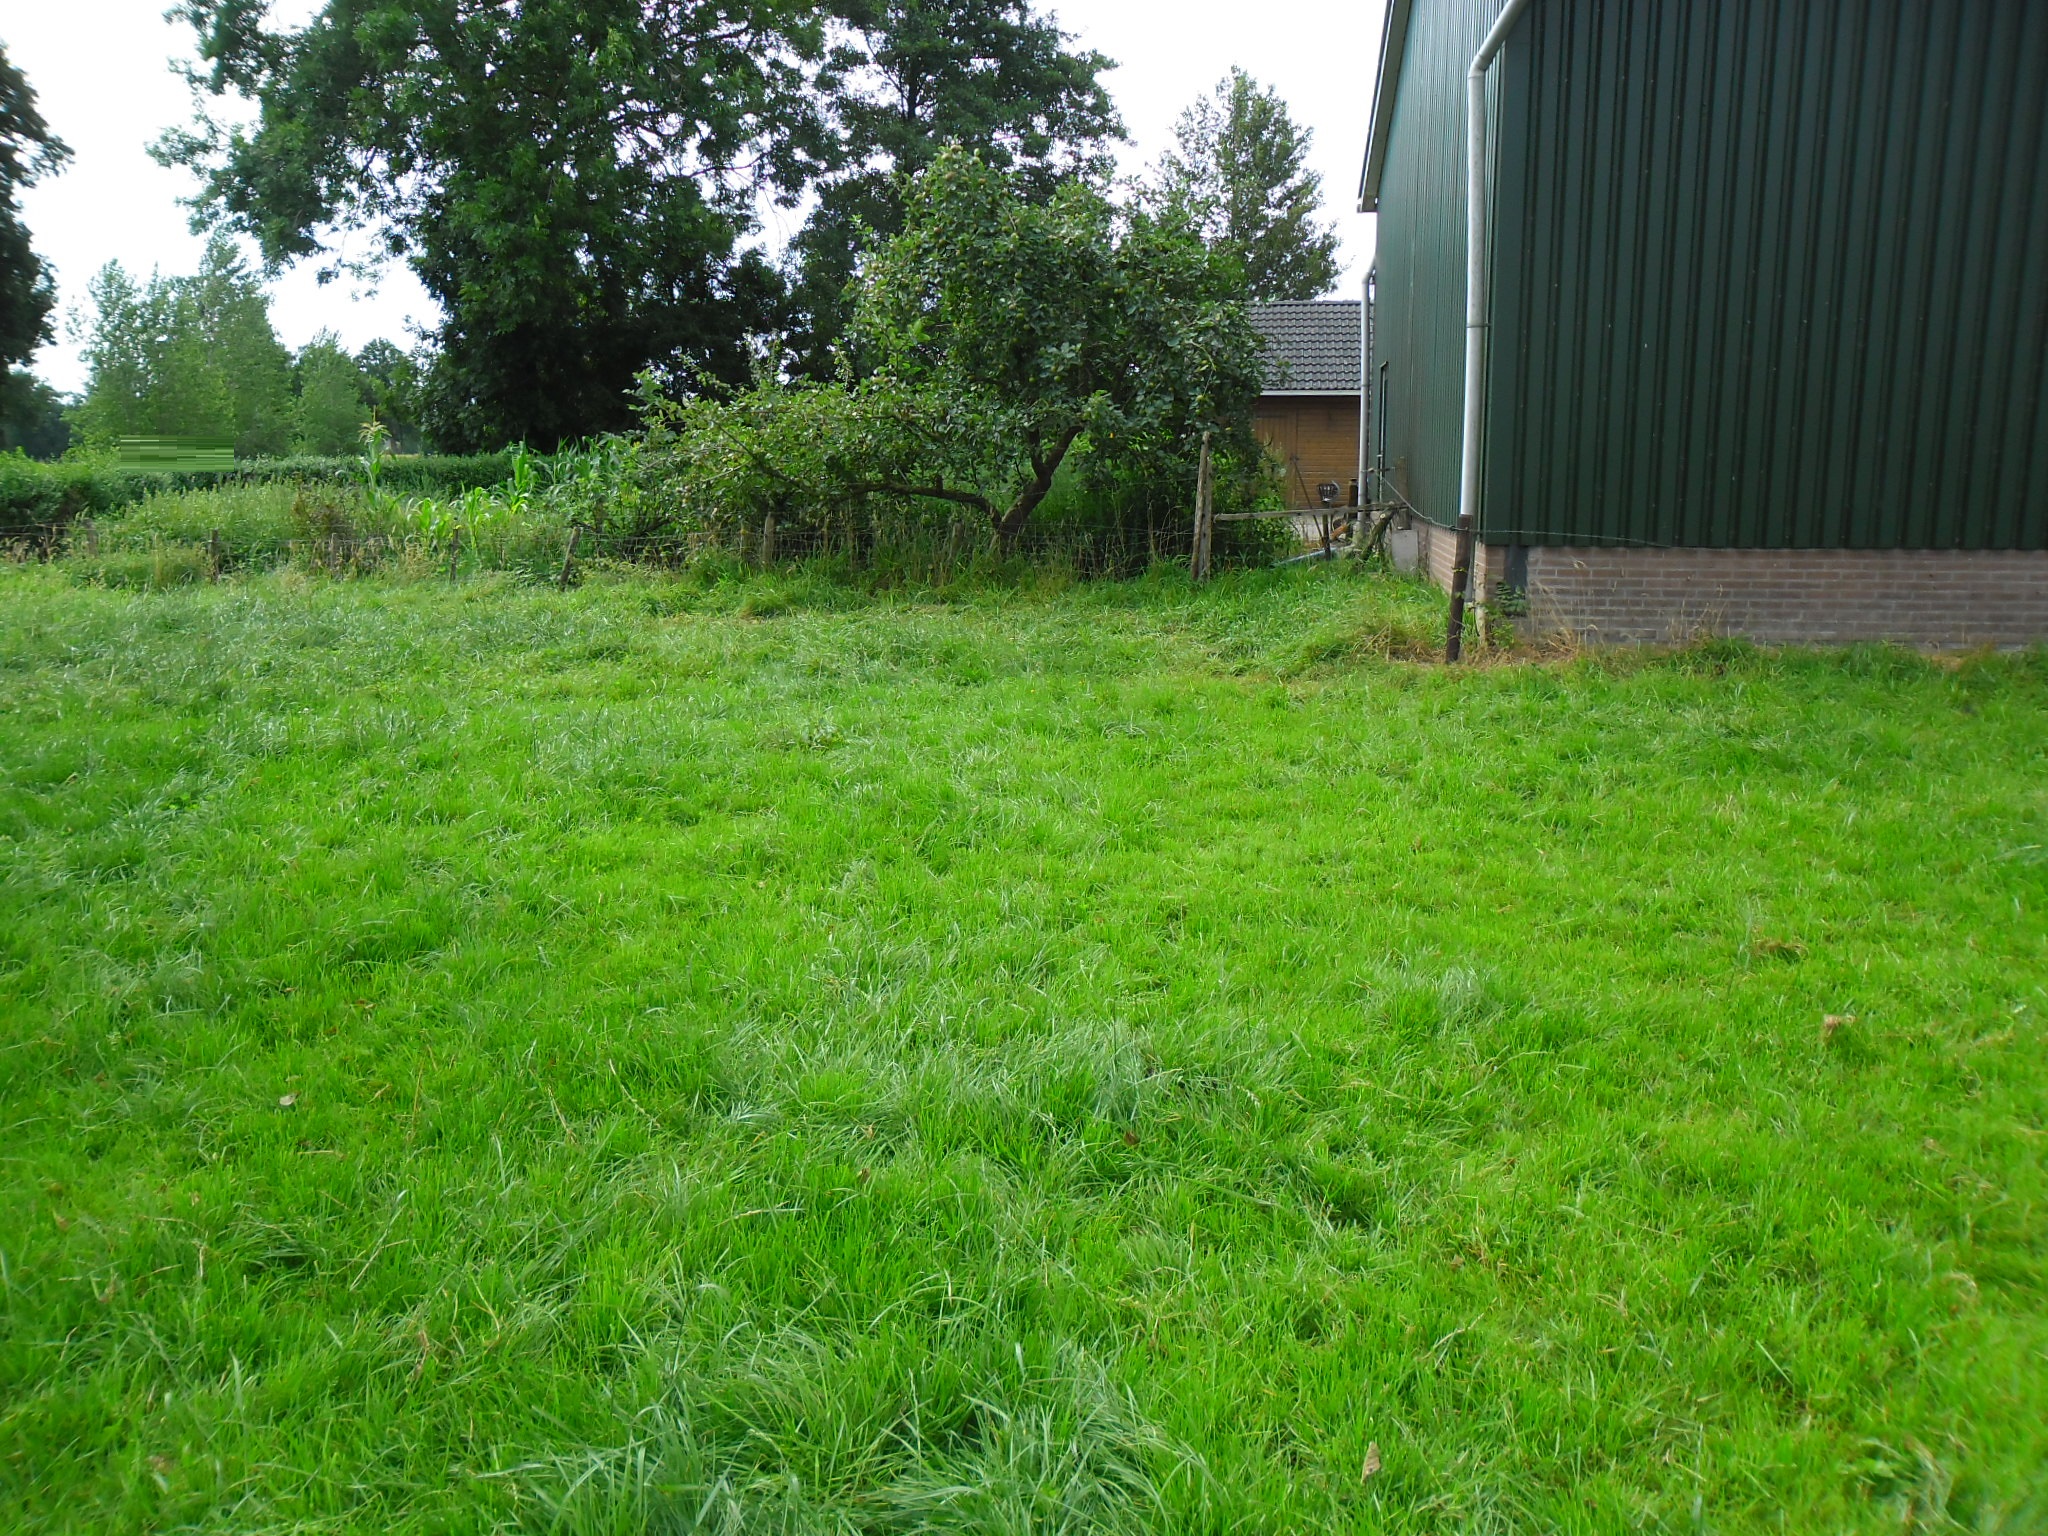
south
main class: Grassland
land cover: Grassland without tree/shrub cover
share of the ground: > 75 %
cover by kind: herbaceous plants 100 %
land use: Agriculture (excluding fallow land and kitchen gardens)
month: August
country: NL
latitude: 52.4442
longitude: 6.2479
